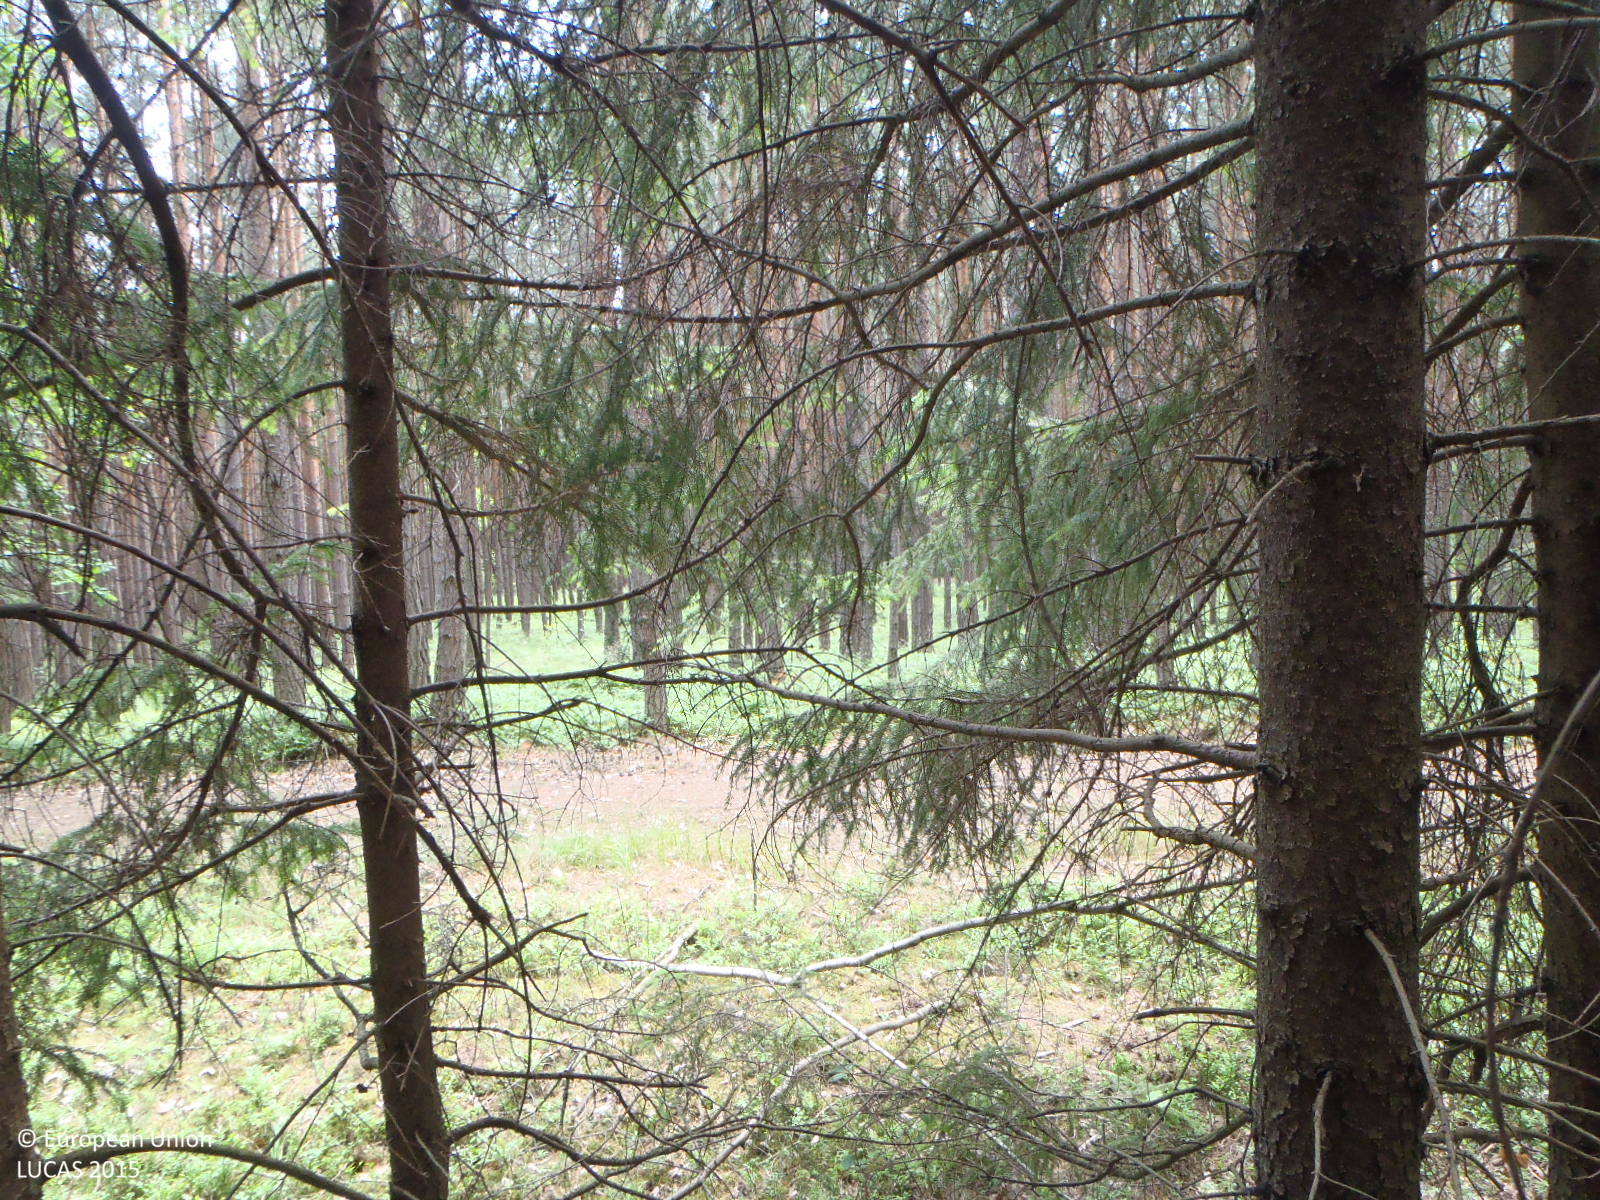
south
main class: Woodland
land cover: Other coniferous woodland
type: hemiboreal forest and nemoral coniferous forest and mixed broadleaved-coniferous forest
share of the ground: > 75 %
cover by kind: coniferous forest trees 95 %, broadleaved forest trees 5 %
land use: Forestry
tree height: > 5 m
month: June
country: CZ
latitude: 48.9472
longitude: 14.3840
